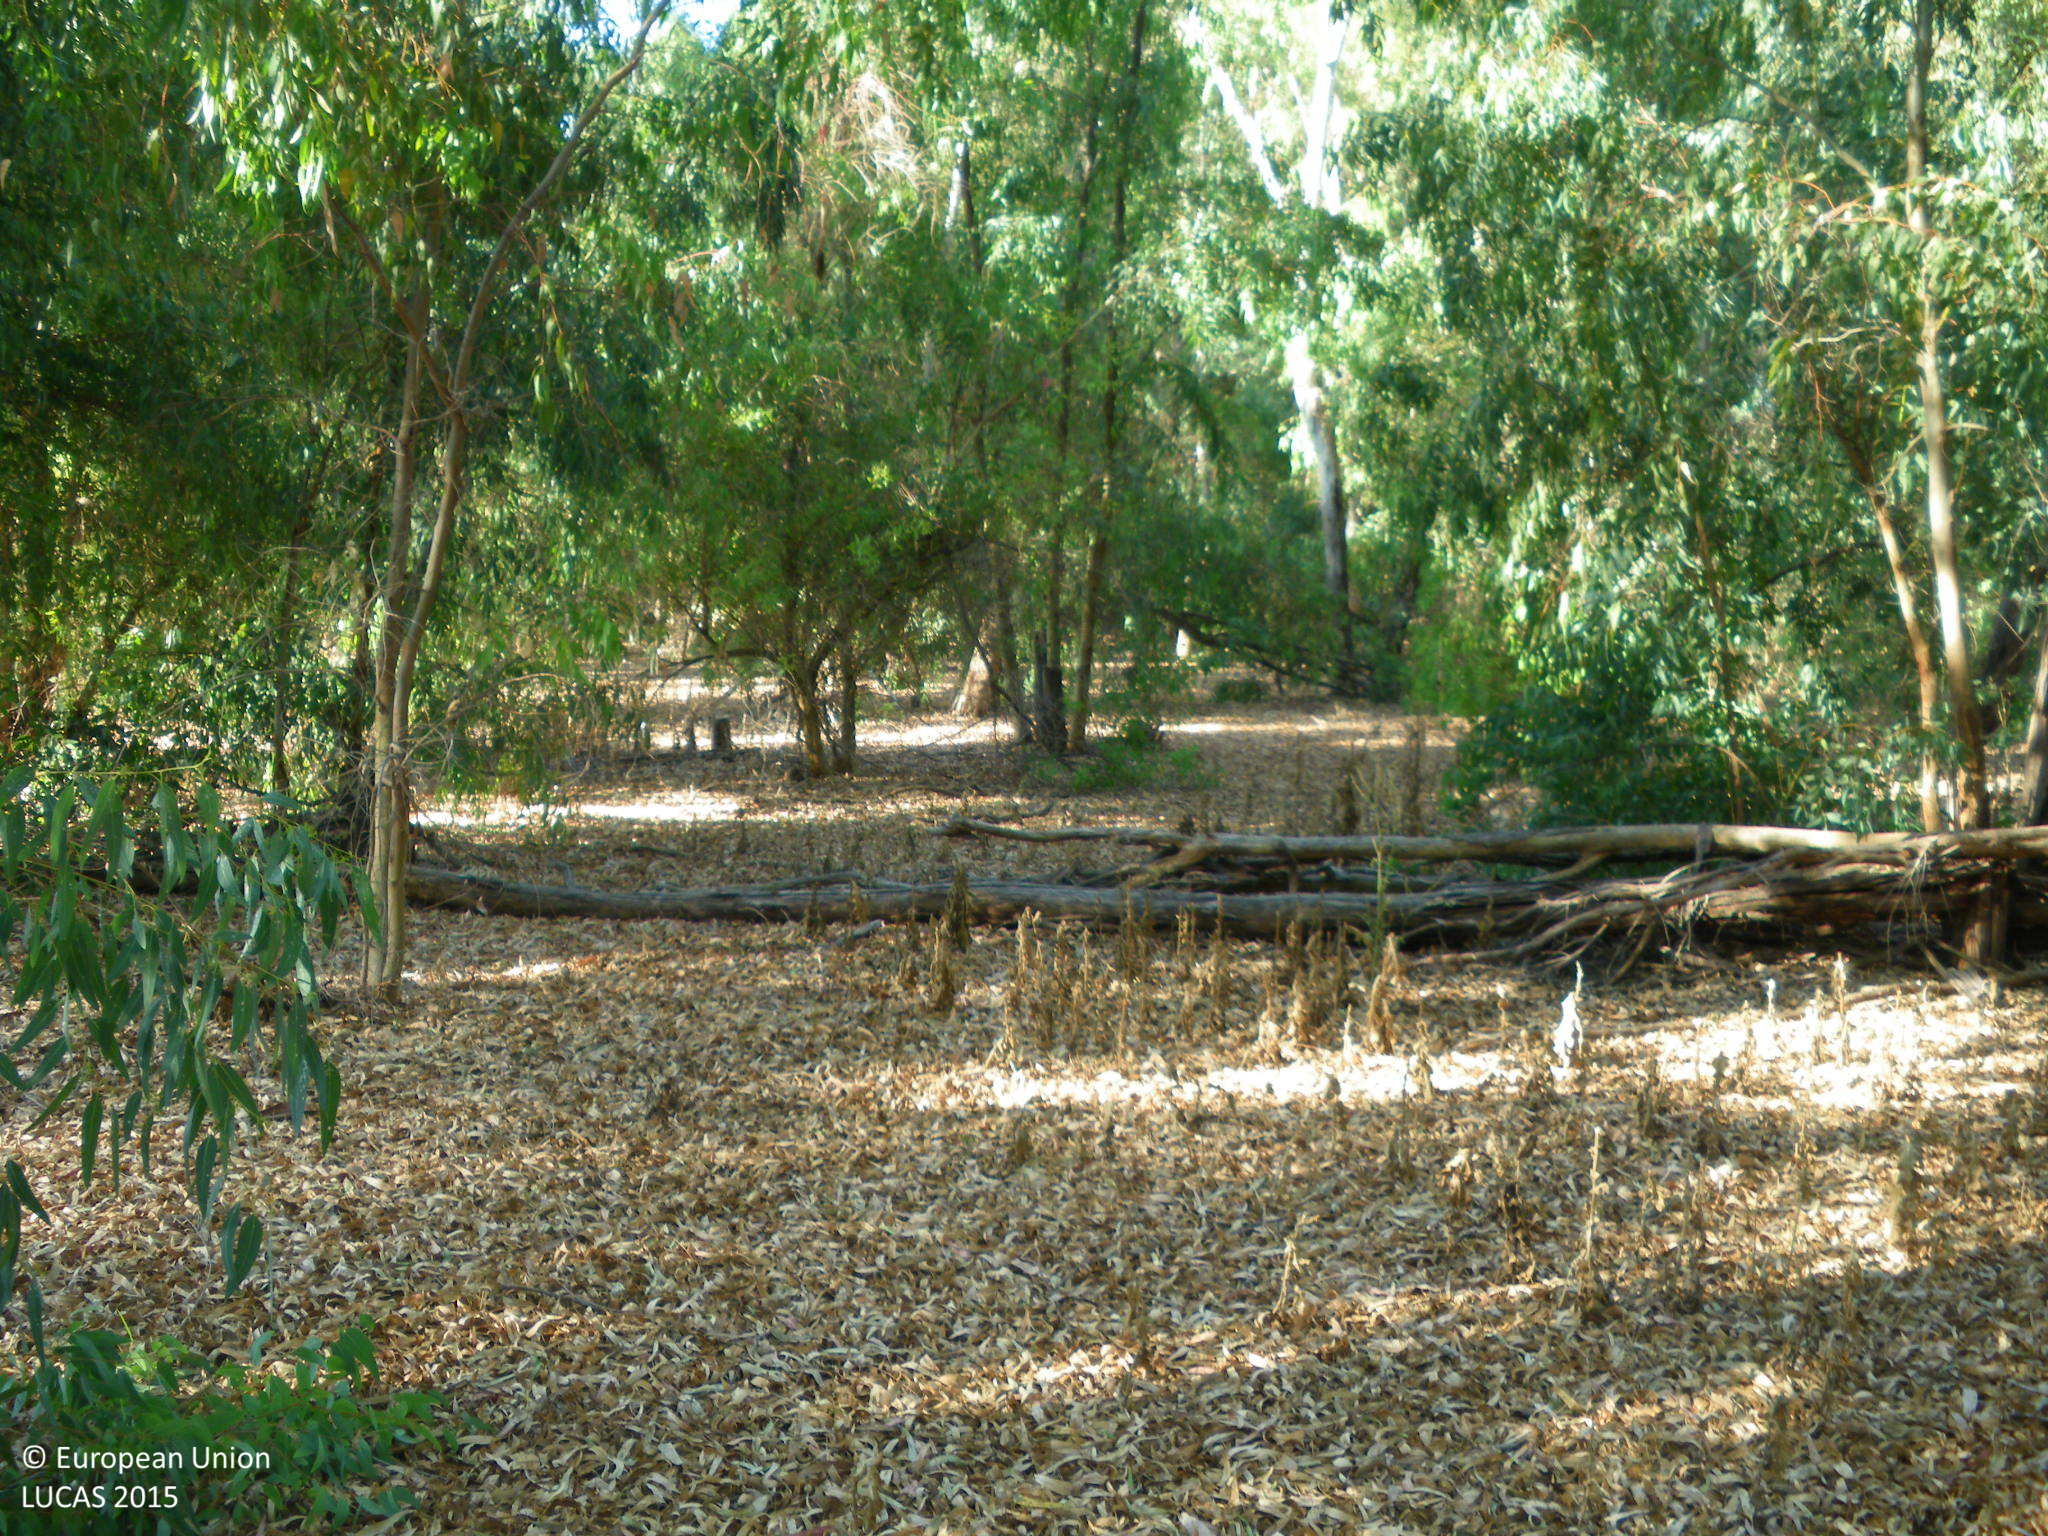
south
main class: Woodland
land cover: Broadleaved woodland
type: exotic forest
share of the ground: 50 - 75 %
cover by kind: broadleaved forest trees 70 %, herbaceous plants 25 %, shrubs 5 %
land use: Semi-natural and natural areas not in use
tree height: > 5 m
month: June
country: ES
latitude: 36.8370
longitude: -5.7184
